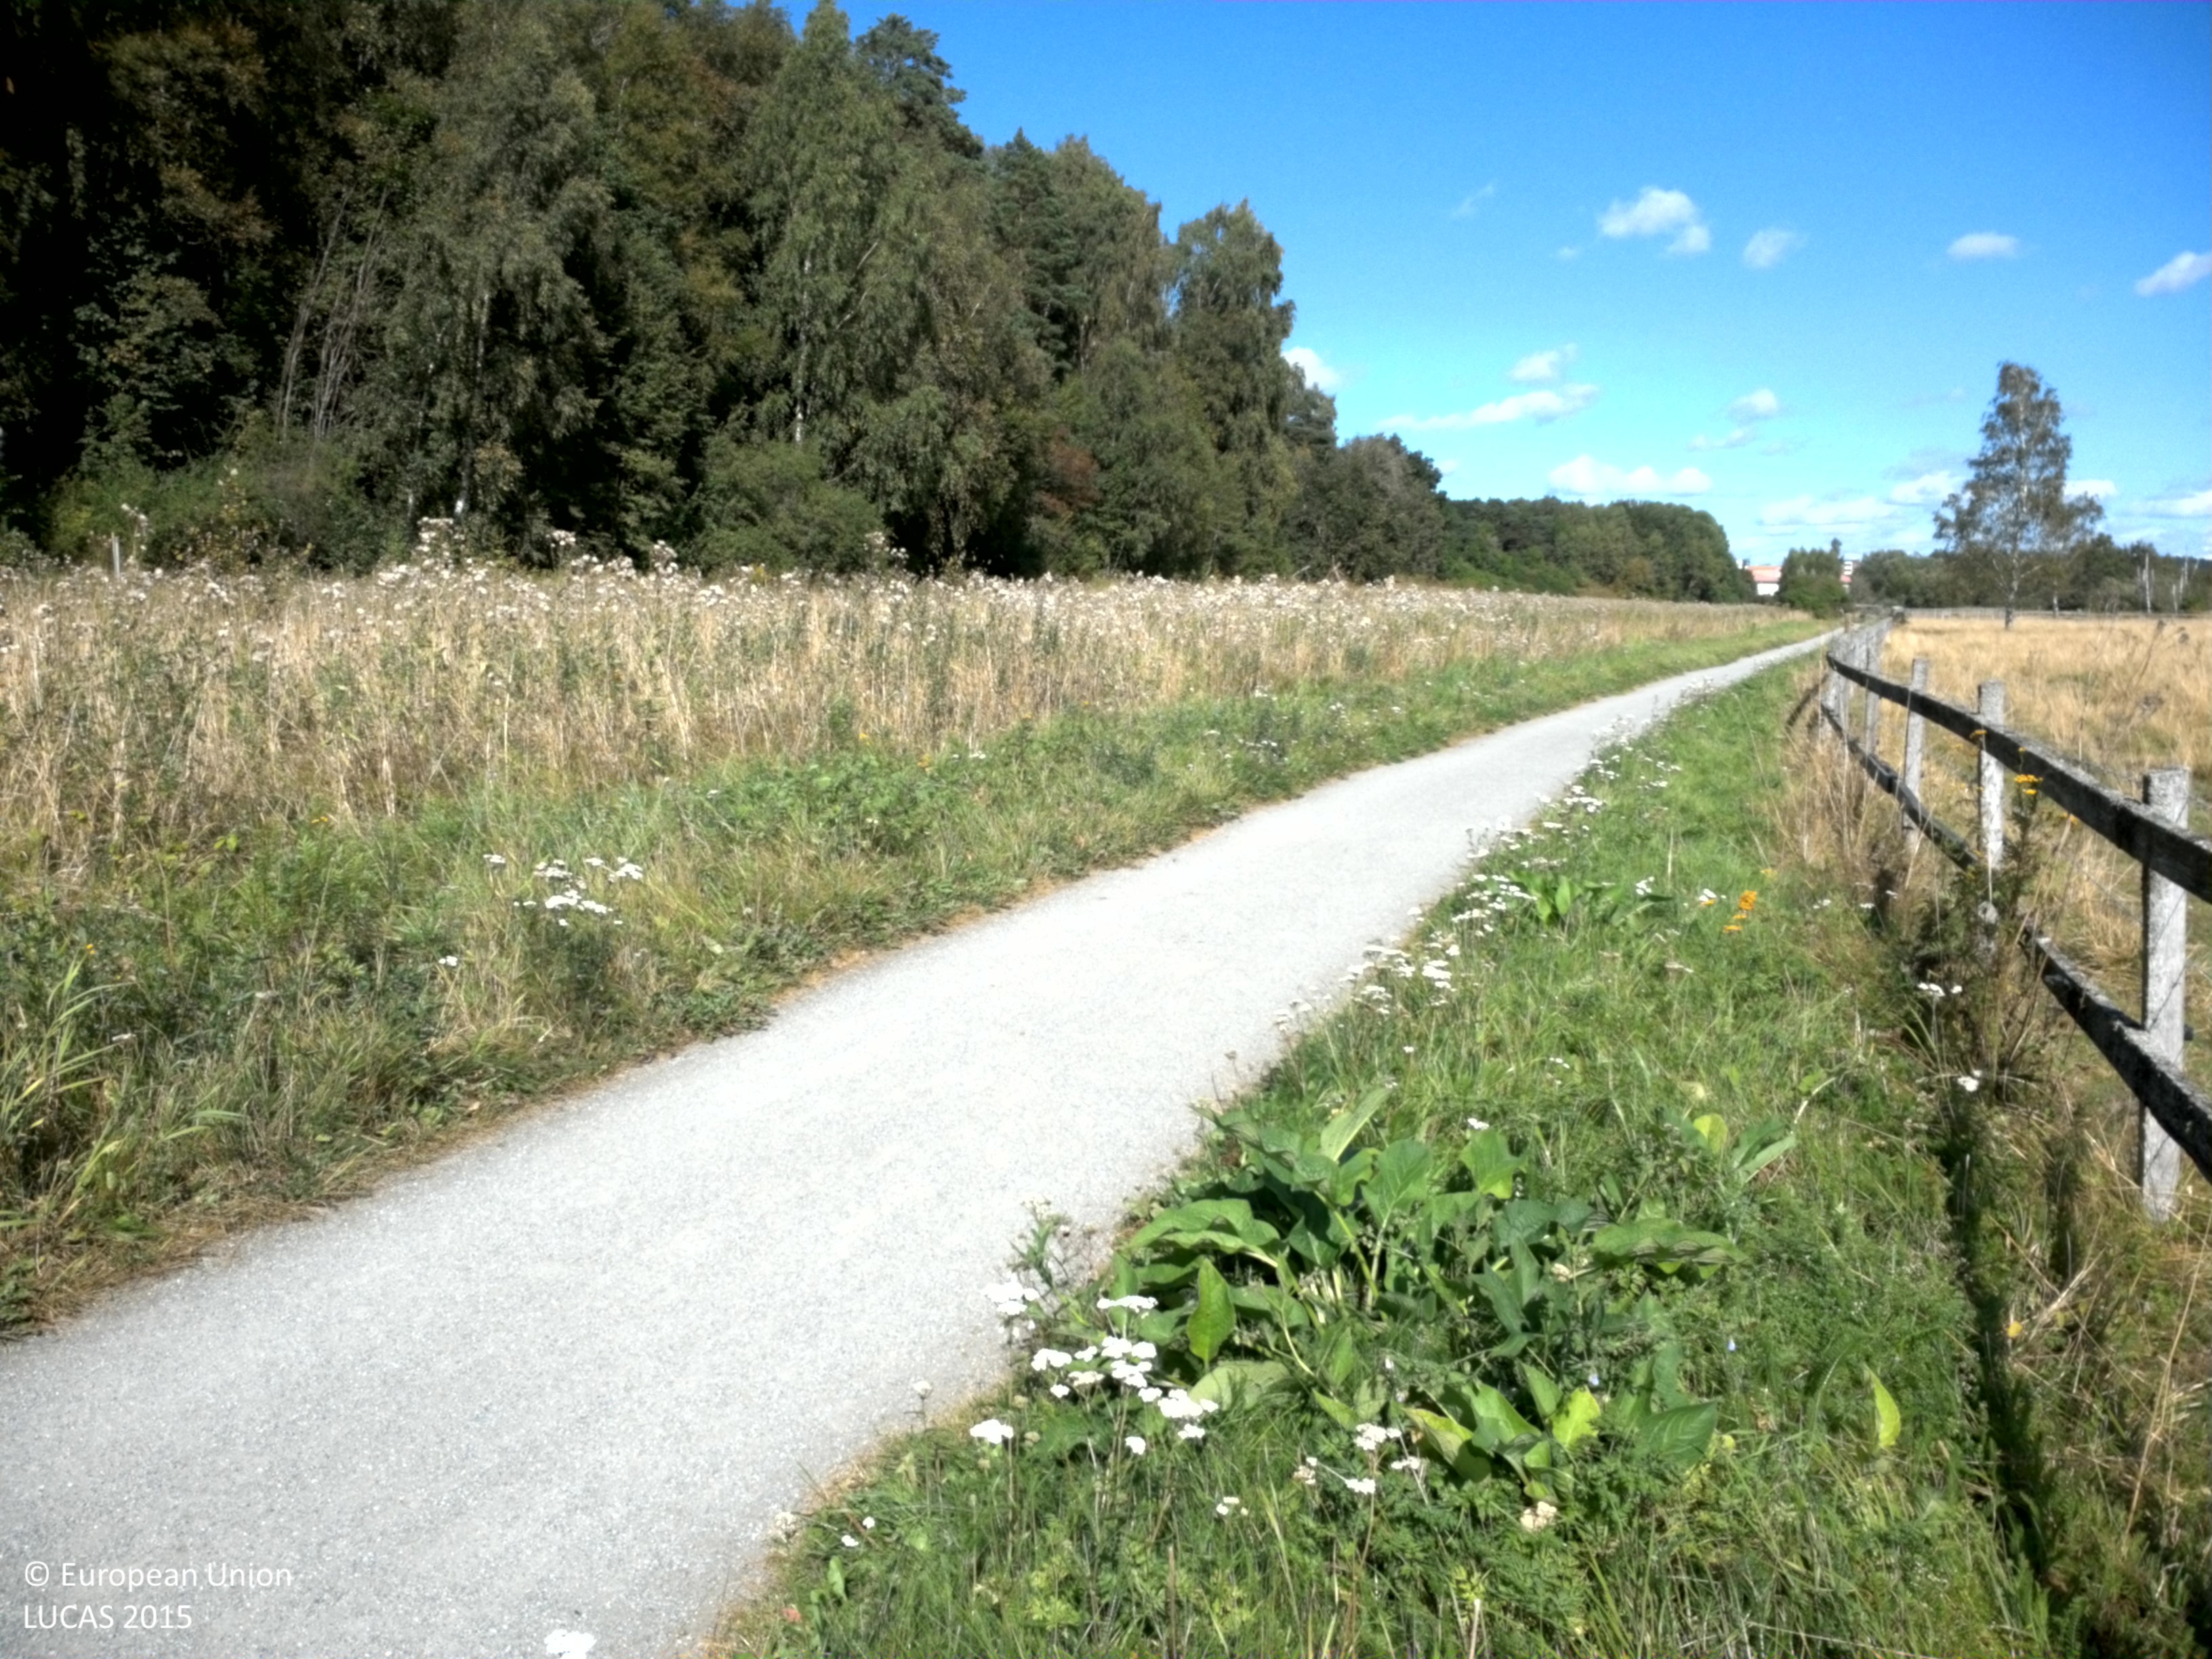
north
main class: Grassland
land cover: Grassland without tree/shrub cover
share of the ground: > 75 %
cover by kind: herbaceous plants 100 %
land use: Agriculture (excluding fallow land and kitchen gardens)
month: August
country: SE
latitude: 59.6238
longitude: 17.0674
